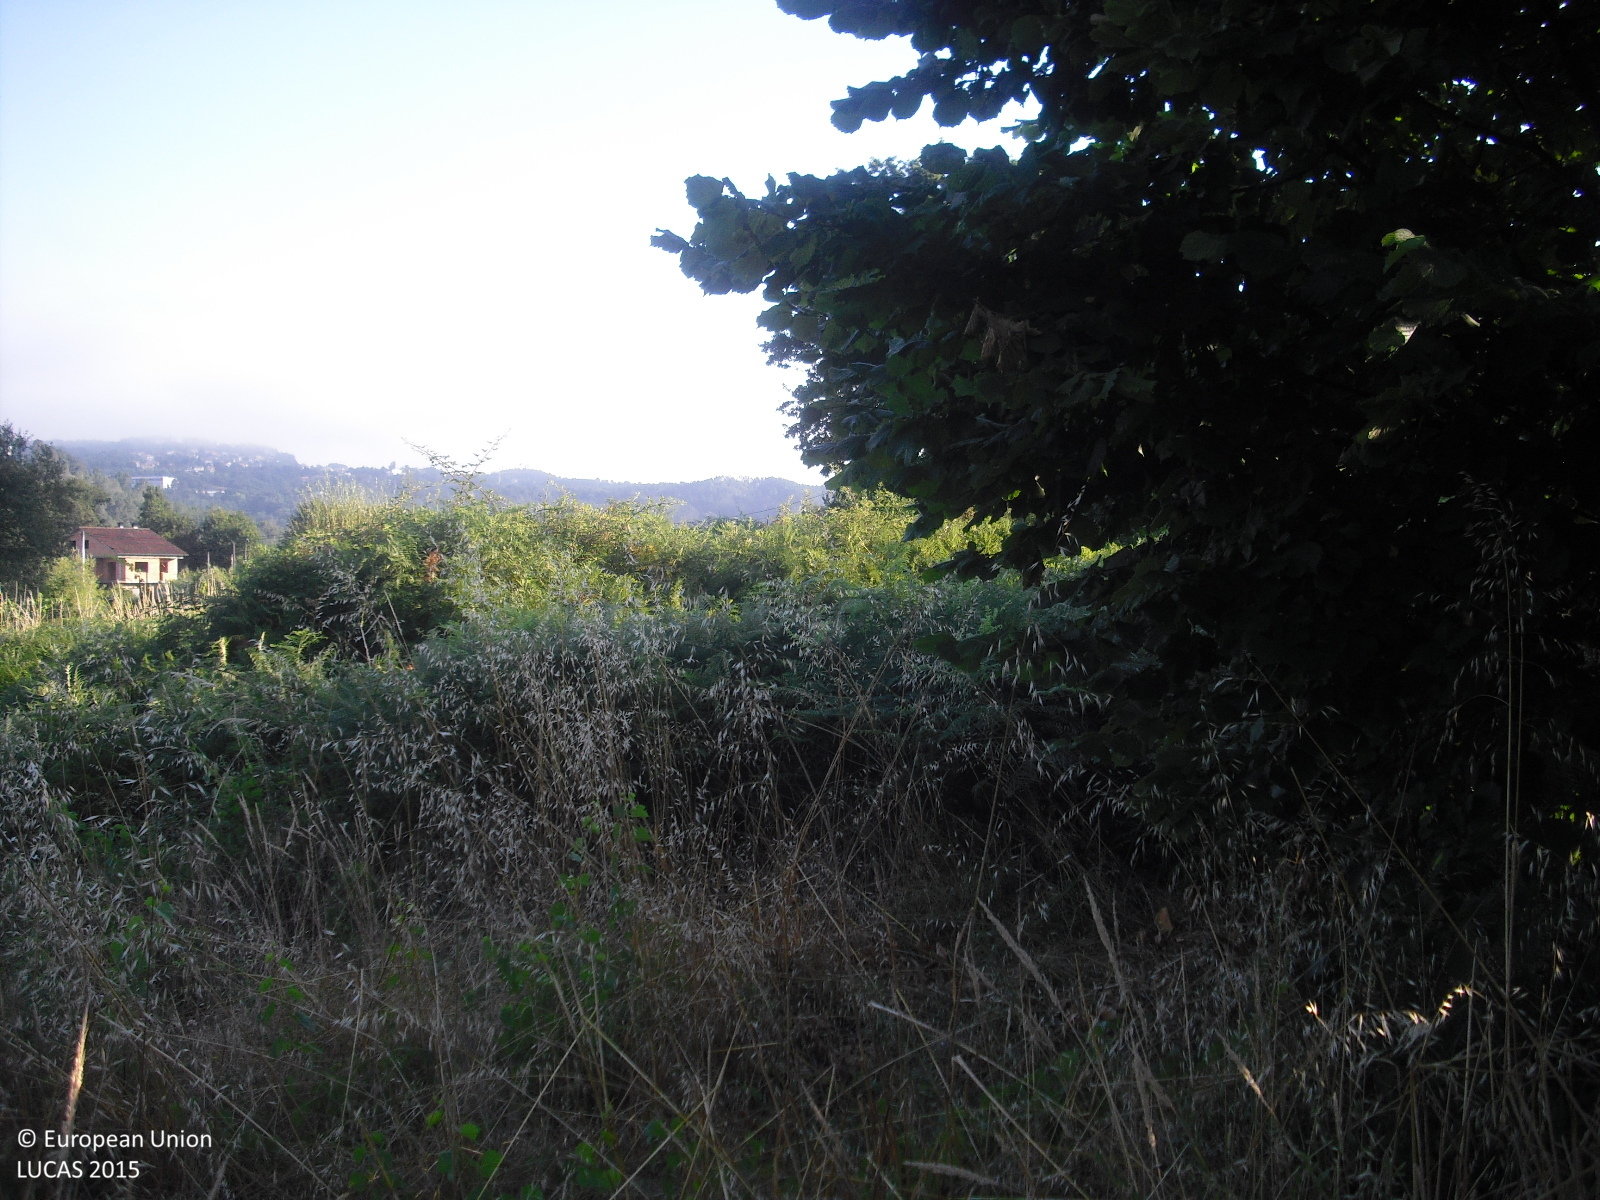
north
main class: Shrubland
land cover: Shrubland with sparse tree cover
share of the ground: 25 - 50 %
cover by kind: herbaceous plants 65 %, shrubs 30 %, broadleaved forest trees 5 %
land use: Abandoned areas
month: June
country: ES
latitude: 42.3647
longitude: -7.8411
